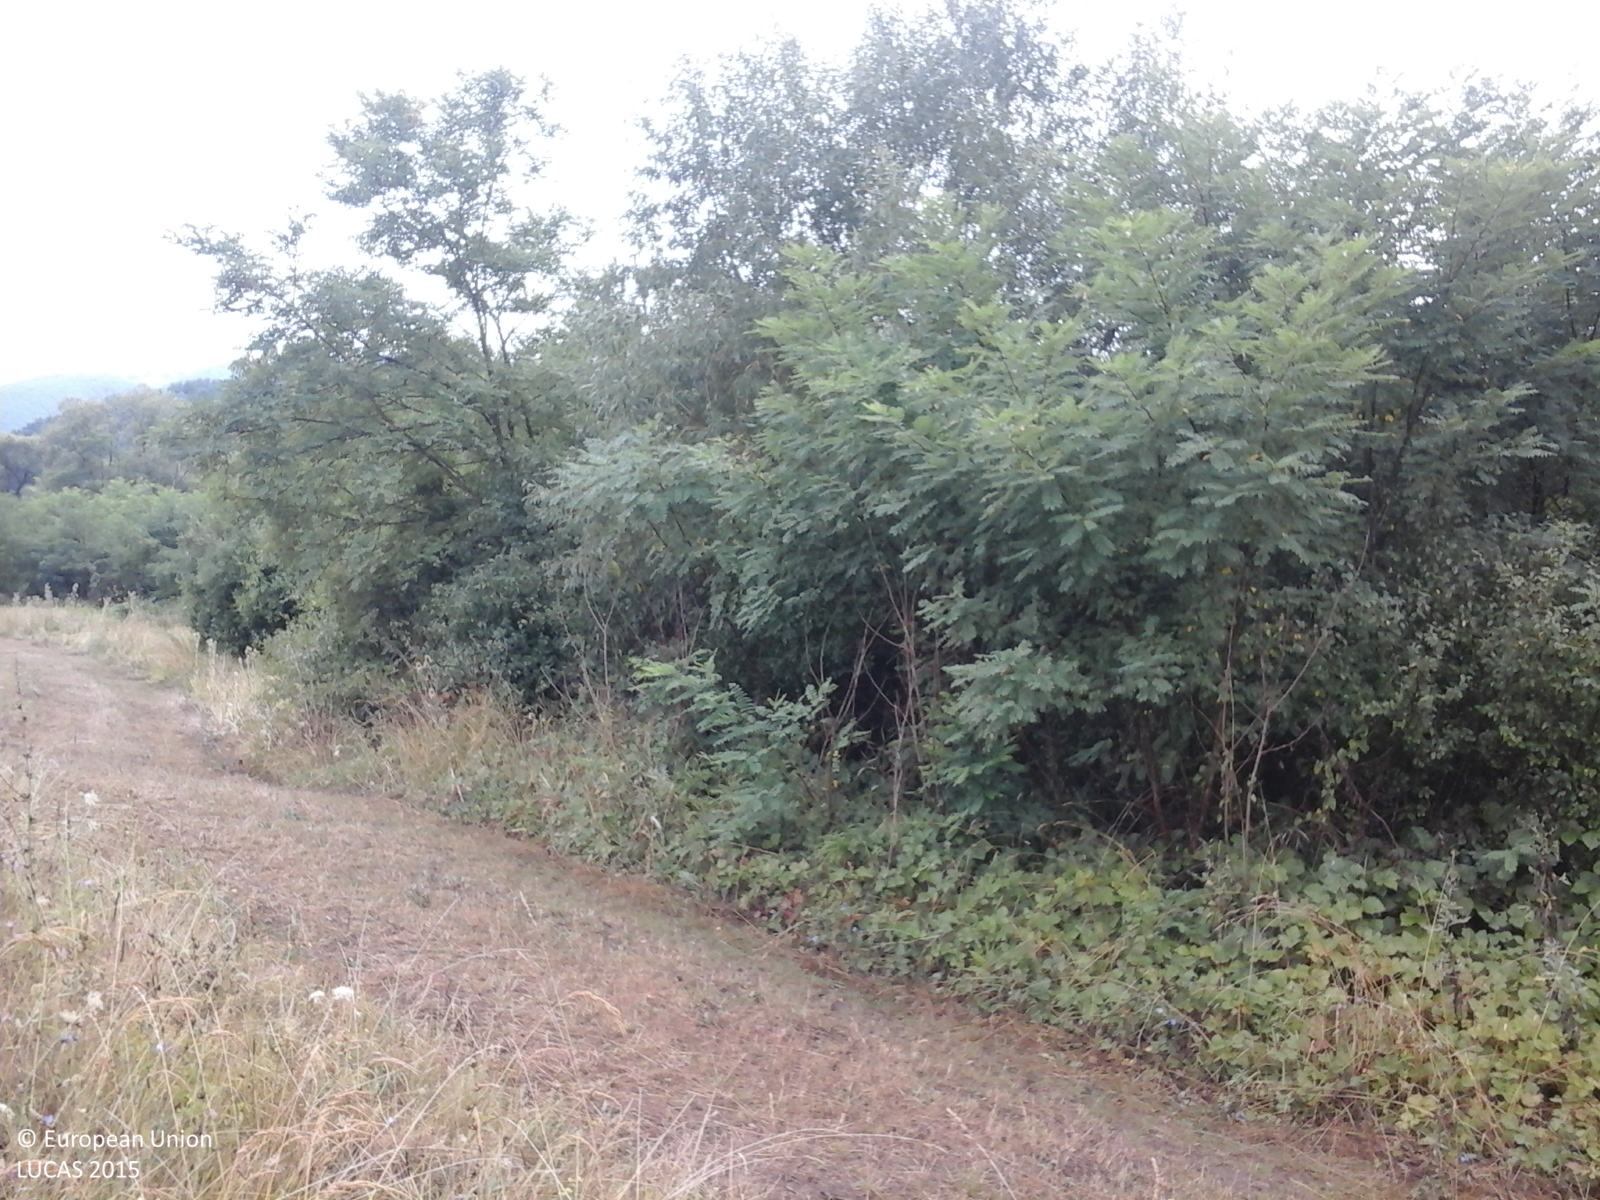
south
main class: Grassland
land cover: Grassland without tree/shrub cover
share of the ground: > 75 %
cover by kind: herbaceous plants 100 %
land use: Agriculture (excluding fallow land and kitchen gardens)
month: August
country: RO
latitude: 44.8694
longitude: 22.0210
